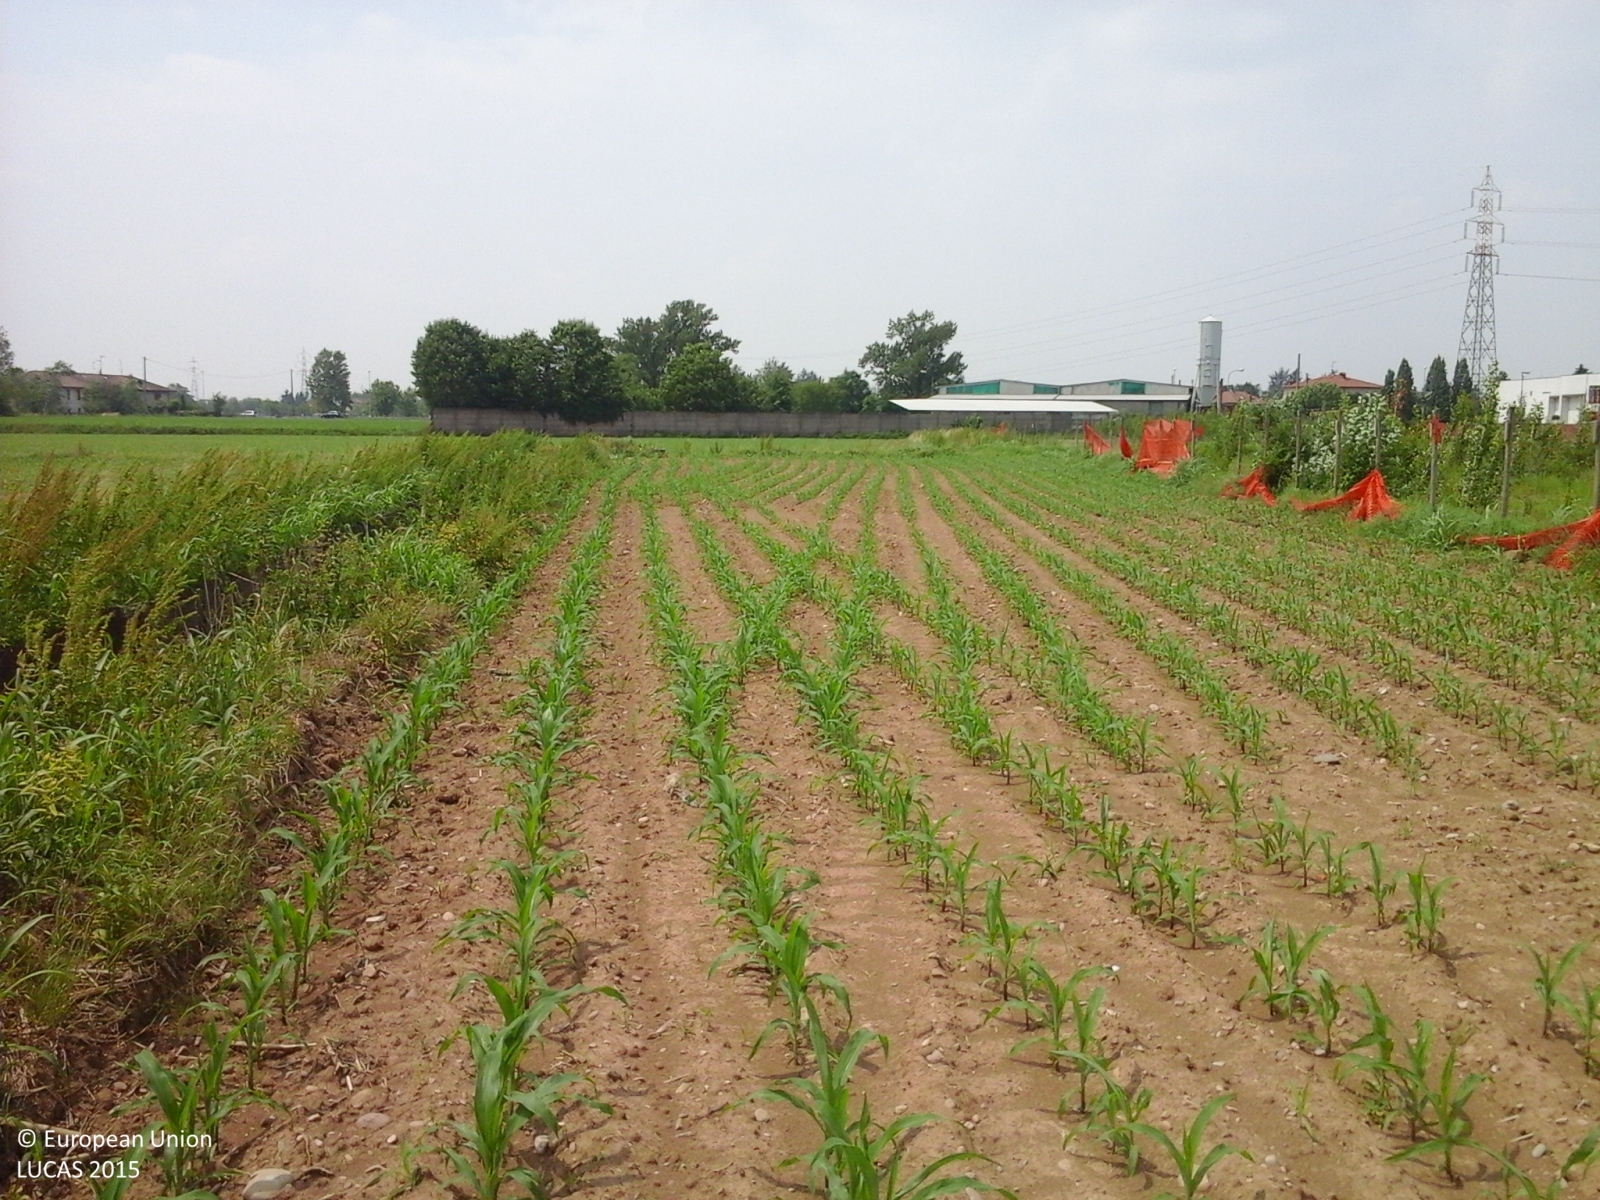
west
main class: Cropland
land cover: Maize
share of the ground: 10 - 25 %
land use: Agriculture (excluding fallow land and kitchen gardens)
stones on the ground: < 10 %
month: May
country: IT
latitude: 45.5397
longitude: 9.6037
